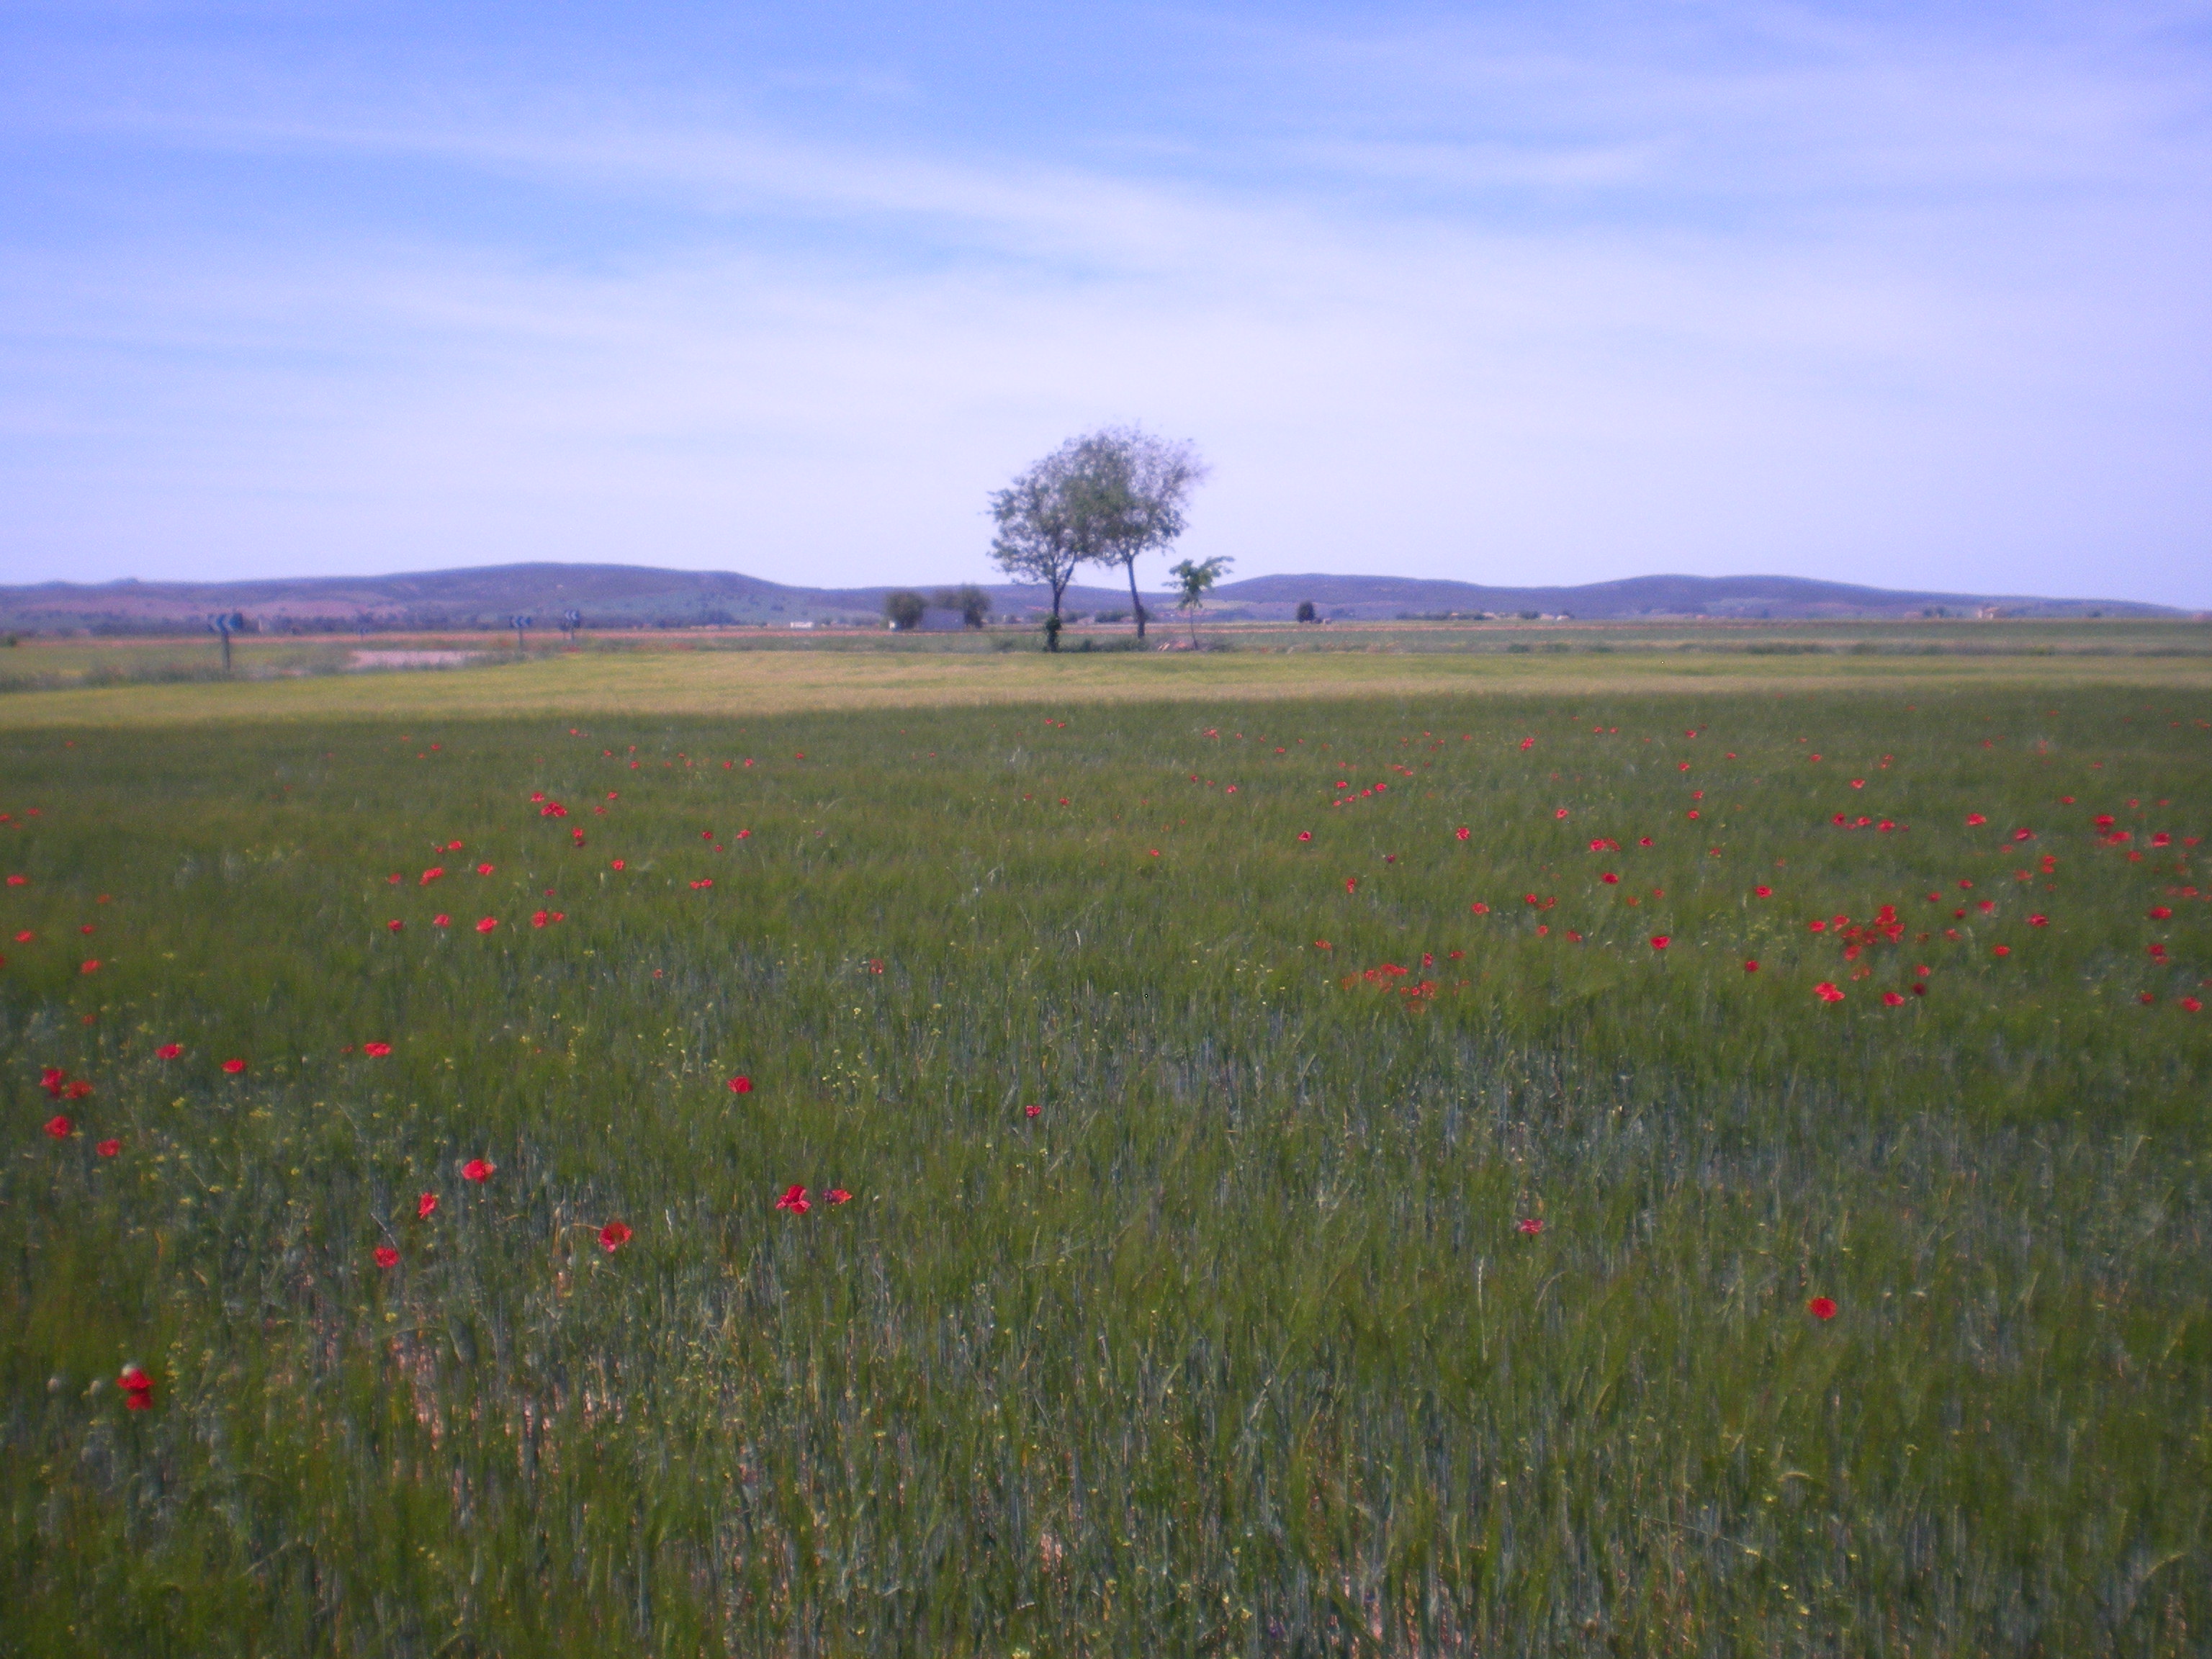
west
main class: Cropland
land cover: Barley
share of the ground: > 75 %
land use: Agriculture (excluding fallow land and kitchen gardens)
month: May
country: ES
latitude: 38.8859
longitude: -3.3971
